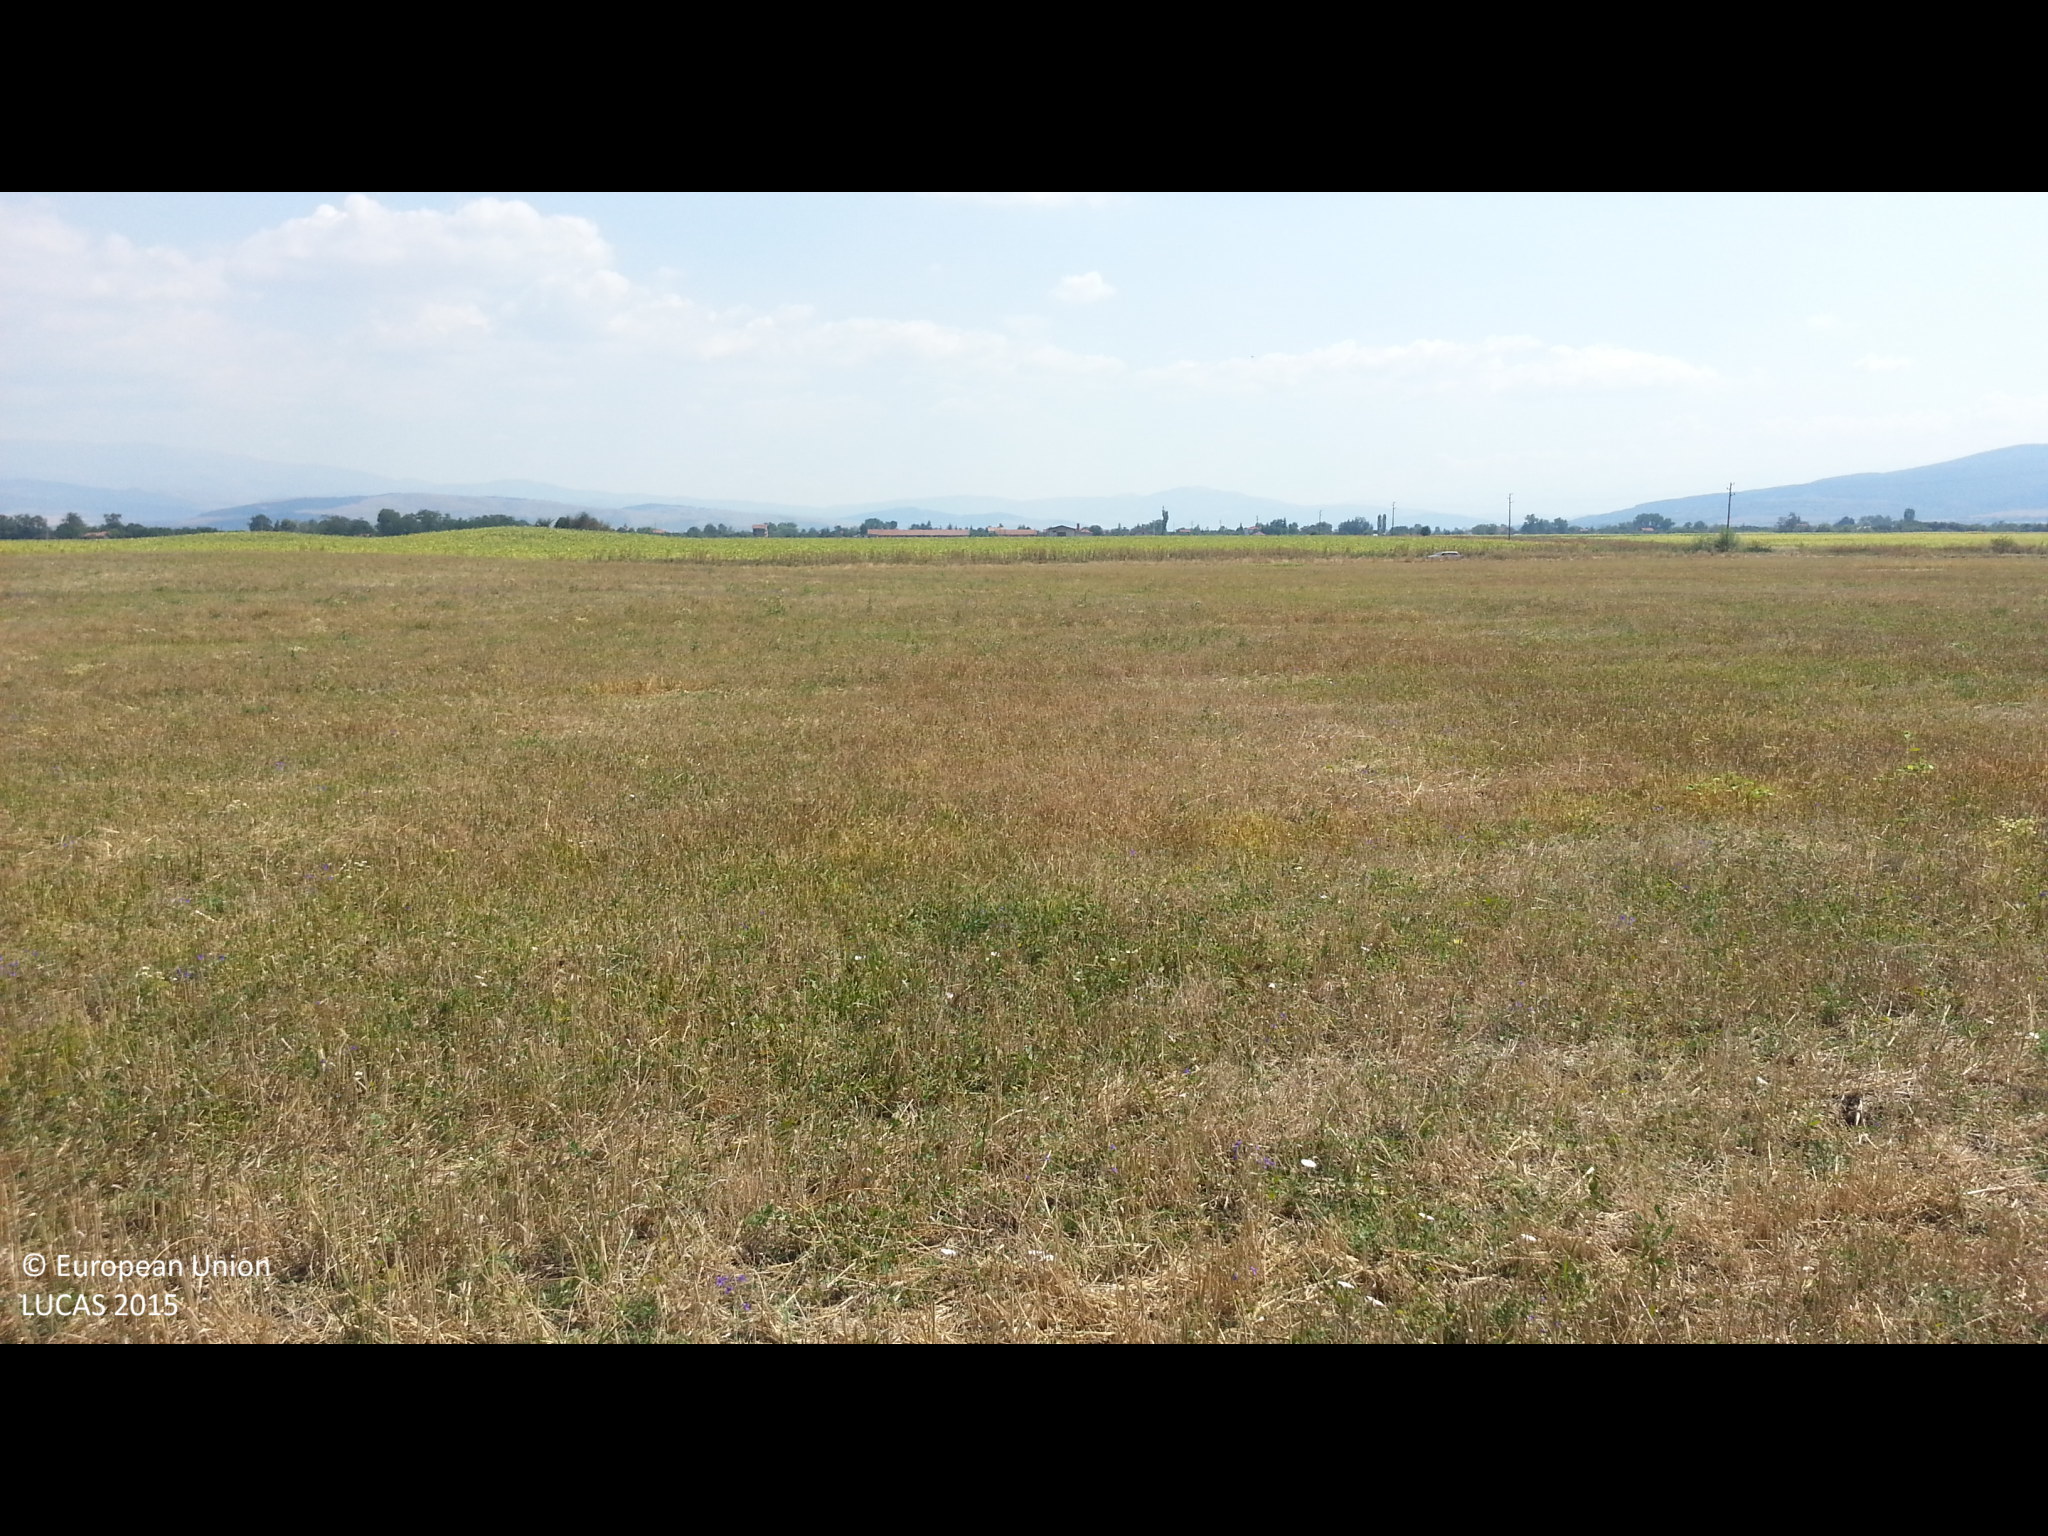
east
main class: Cropland
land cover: Common wheat
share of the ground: > 75 %
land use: Agriculture (excluding fallow land and kitchen gardens)
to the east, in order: Common wheat; Tracks; Grass margins; Ditches and canals; Grass margins; Sunflower
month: August
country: BG
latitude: 42.4608
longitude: 22.9293
